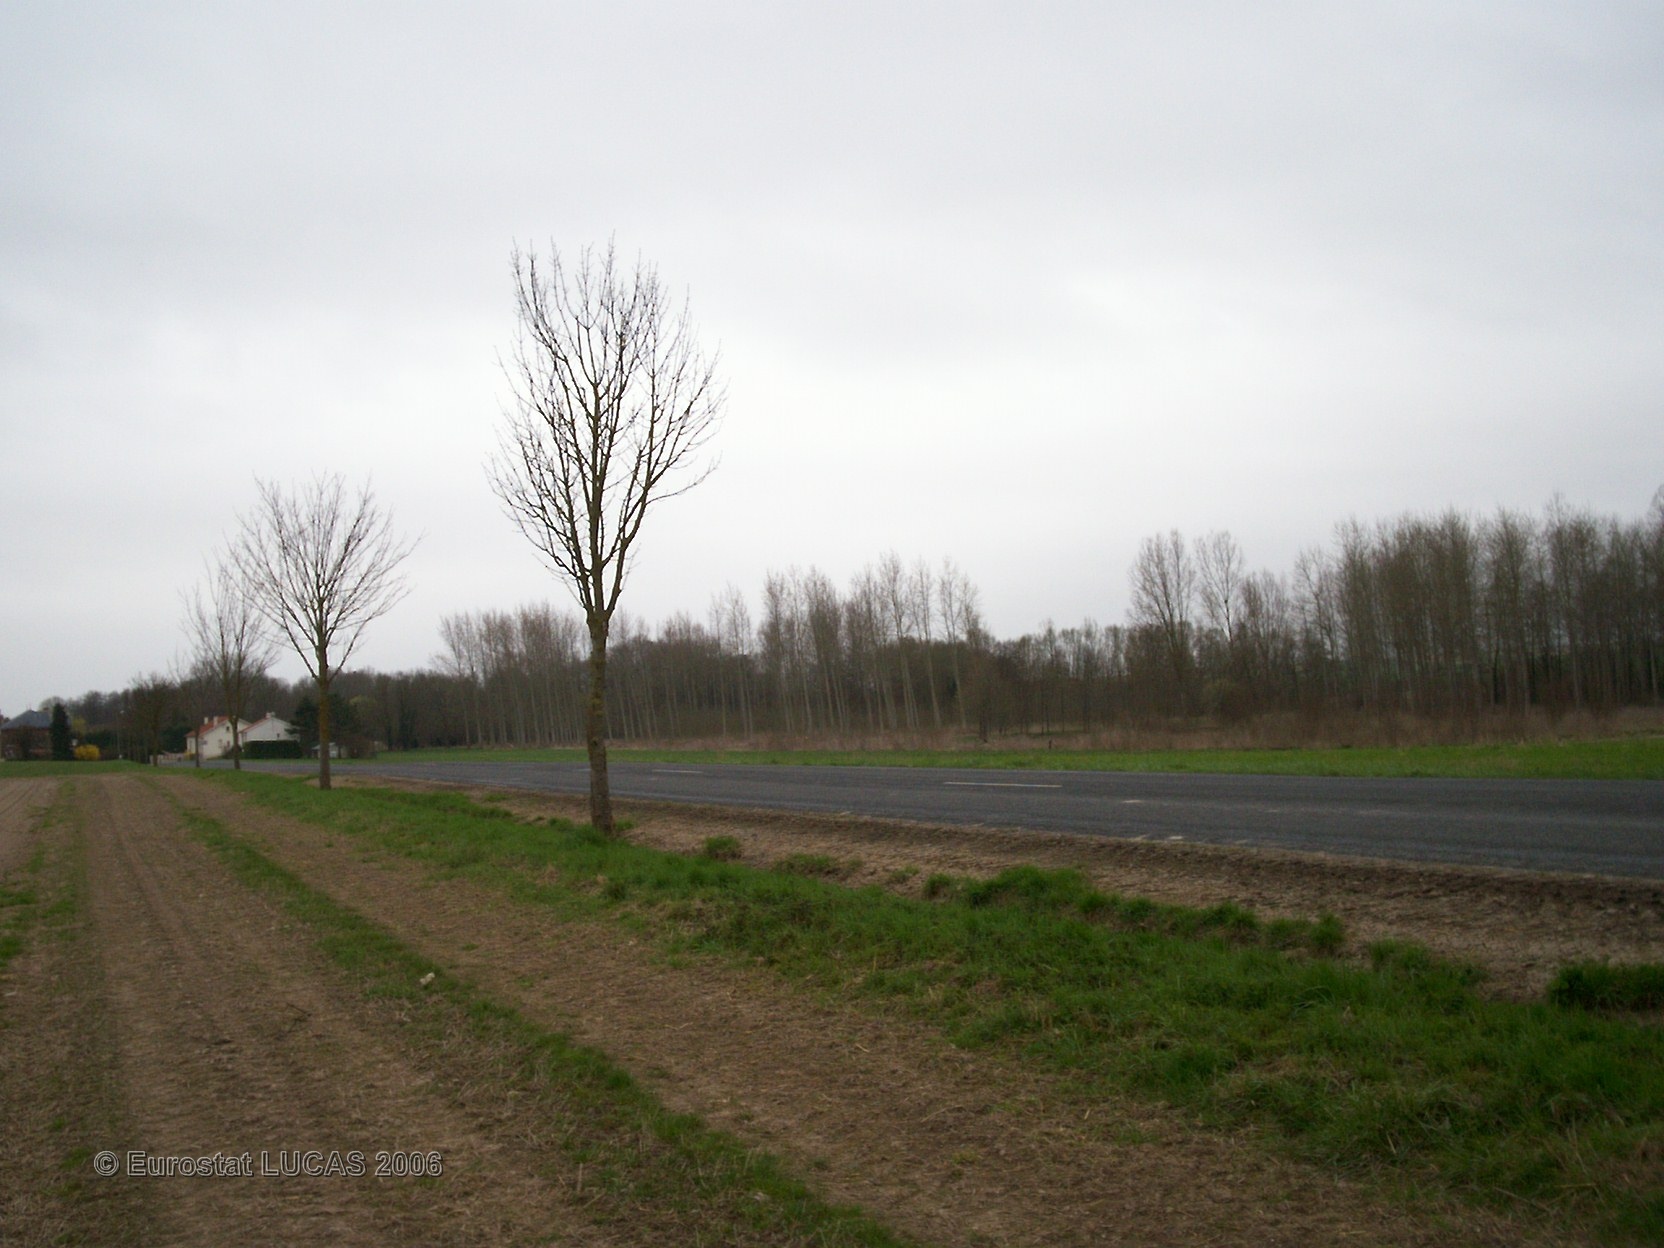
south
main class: Cropland
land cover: Sugar beet
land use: Agriculture (excluding fallow land and kitchen gardens)
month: June
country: FR
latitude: 49.2536
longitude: 4.4044
